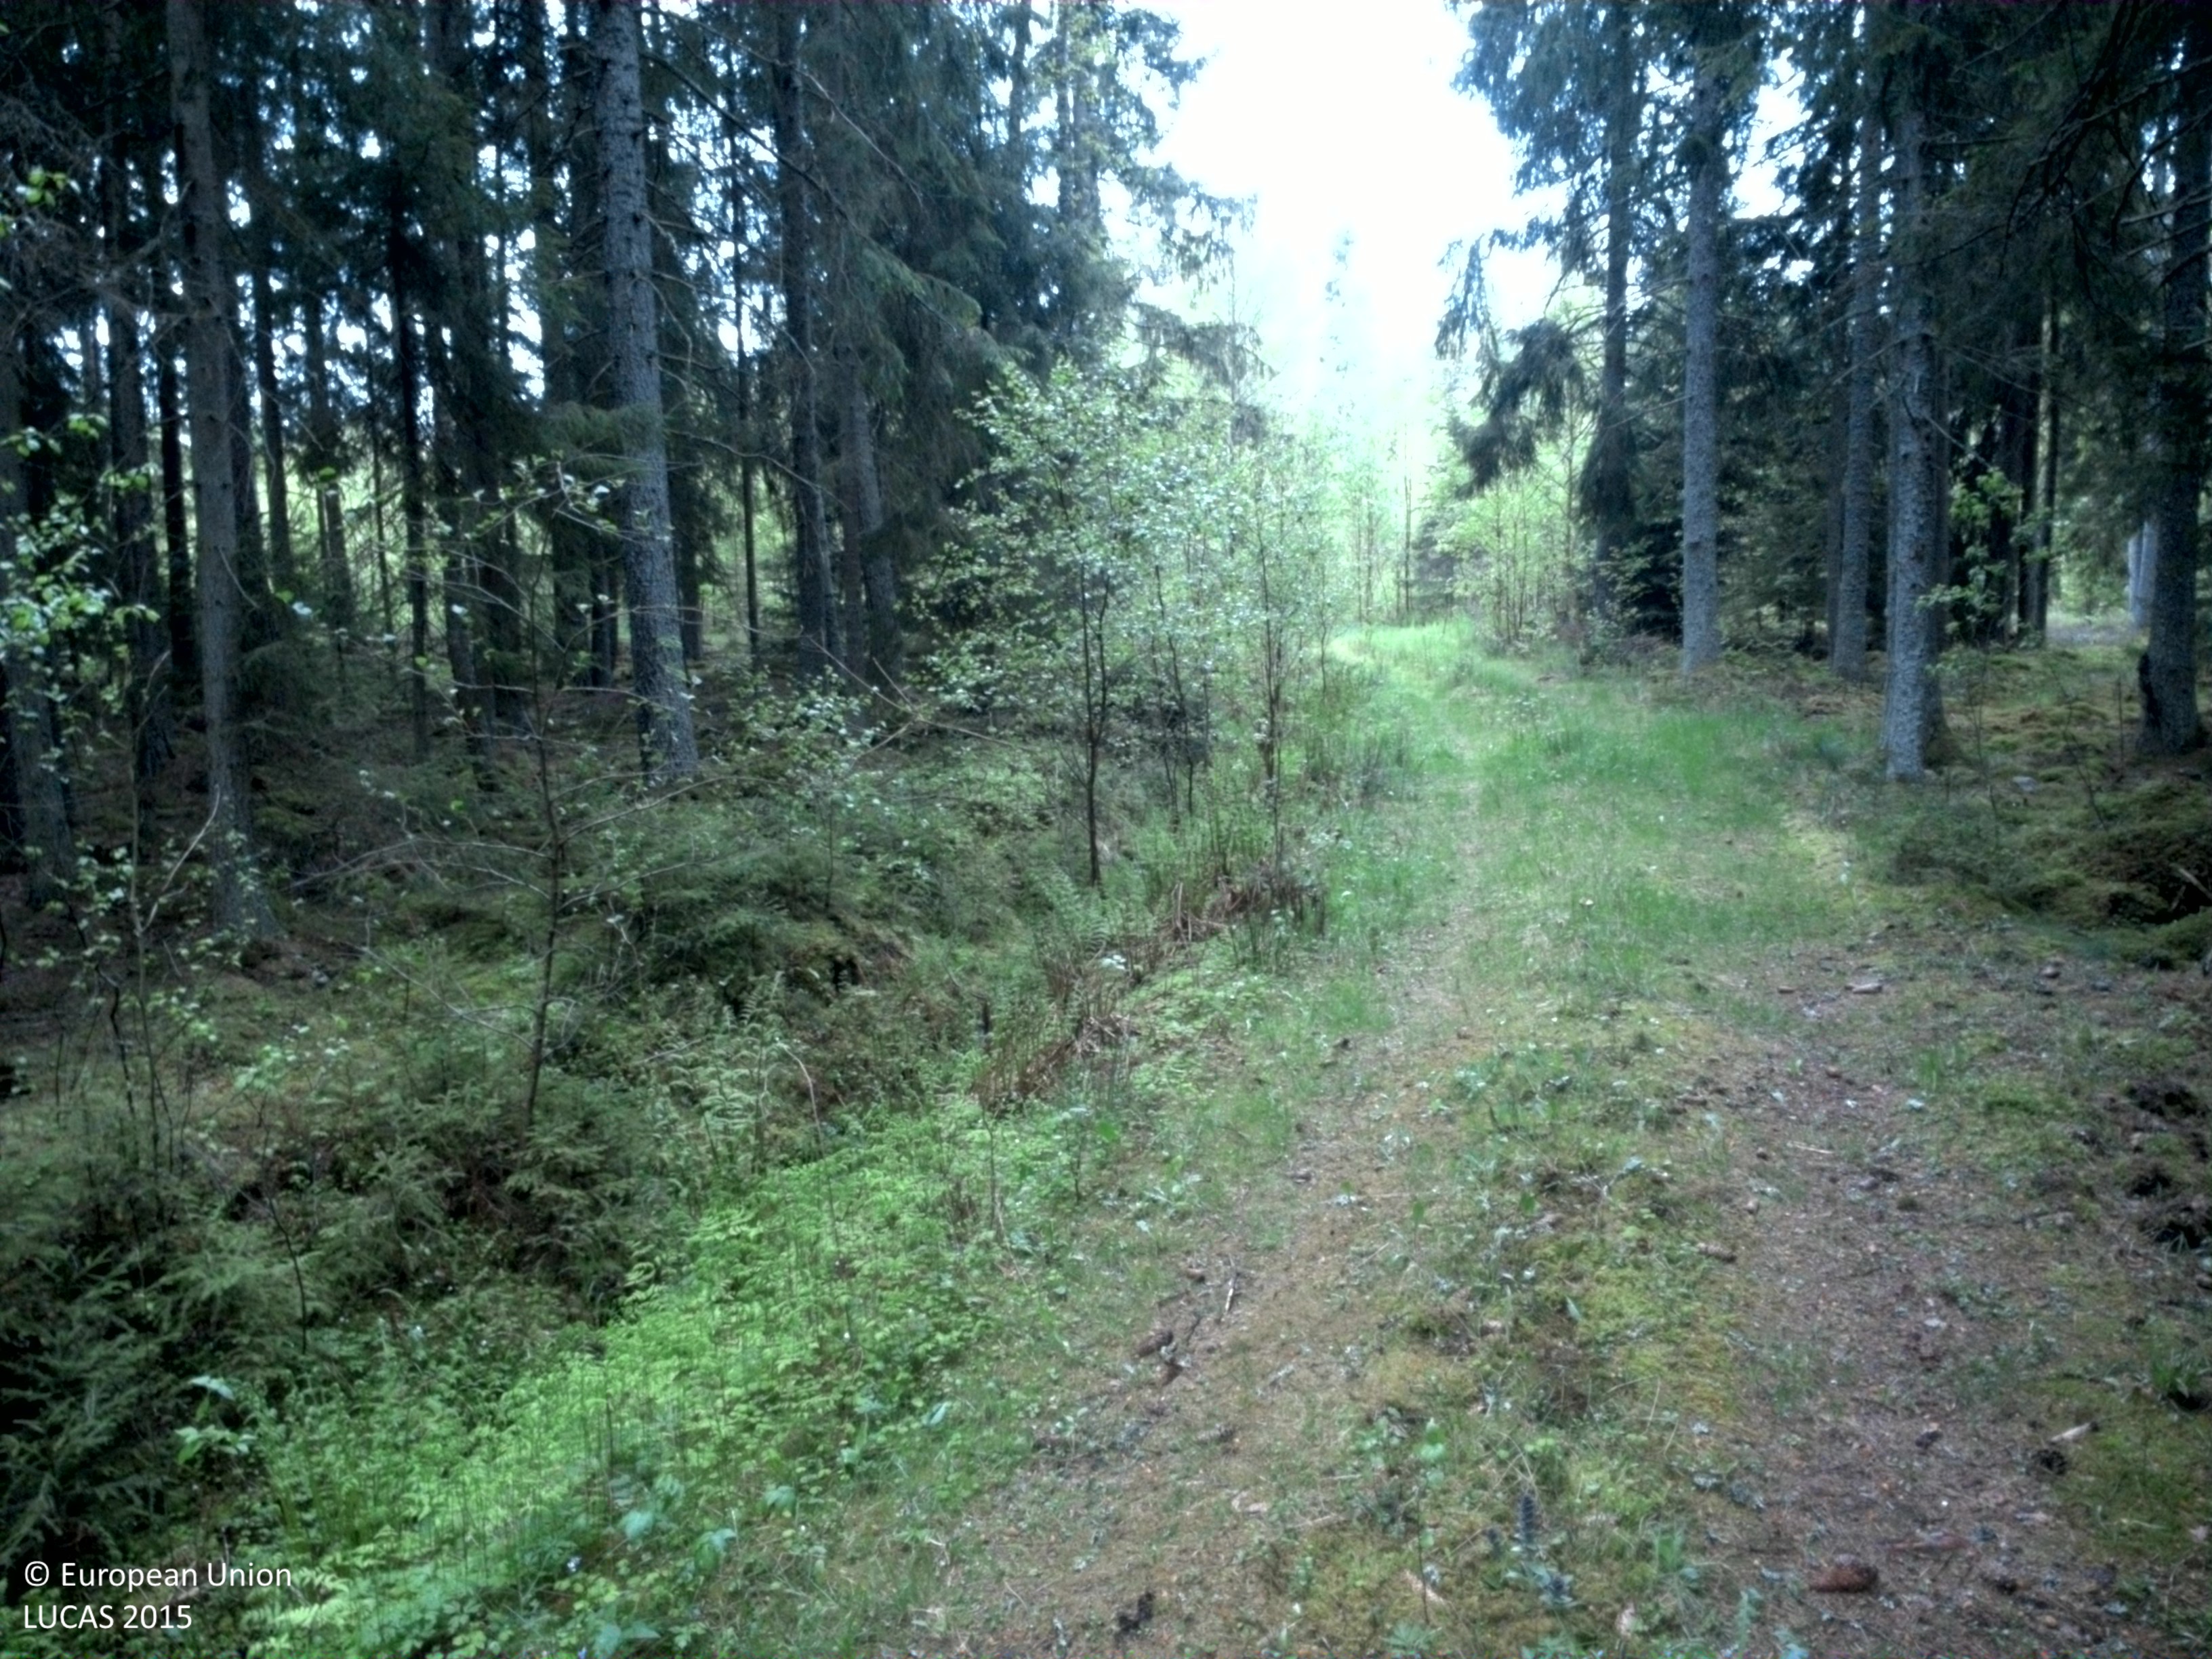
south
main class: Woodland
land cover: Spruce dominated coniferous woodland
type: boreal forest
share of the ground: 50 - 75 %
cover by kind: coniferous forest trees 50 %, lichens and mosses 30 %, broadleaved forest trees 10 %, shrubs 5 %, herbaceous plants 5 %
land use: Forestry
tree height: > 5 m
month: May
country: SE
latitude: 57.3938
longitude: 15.3045
